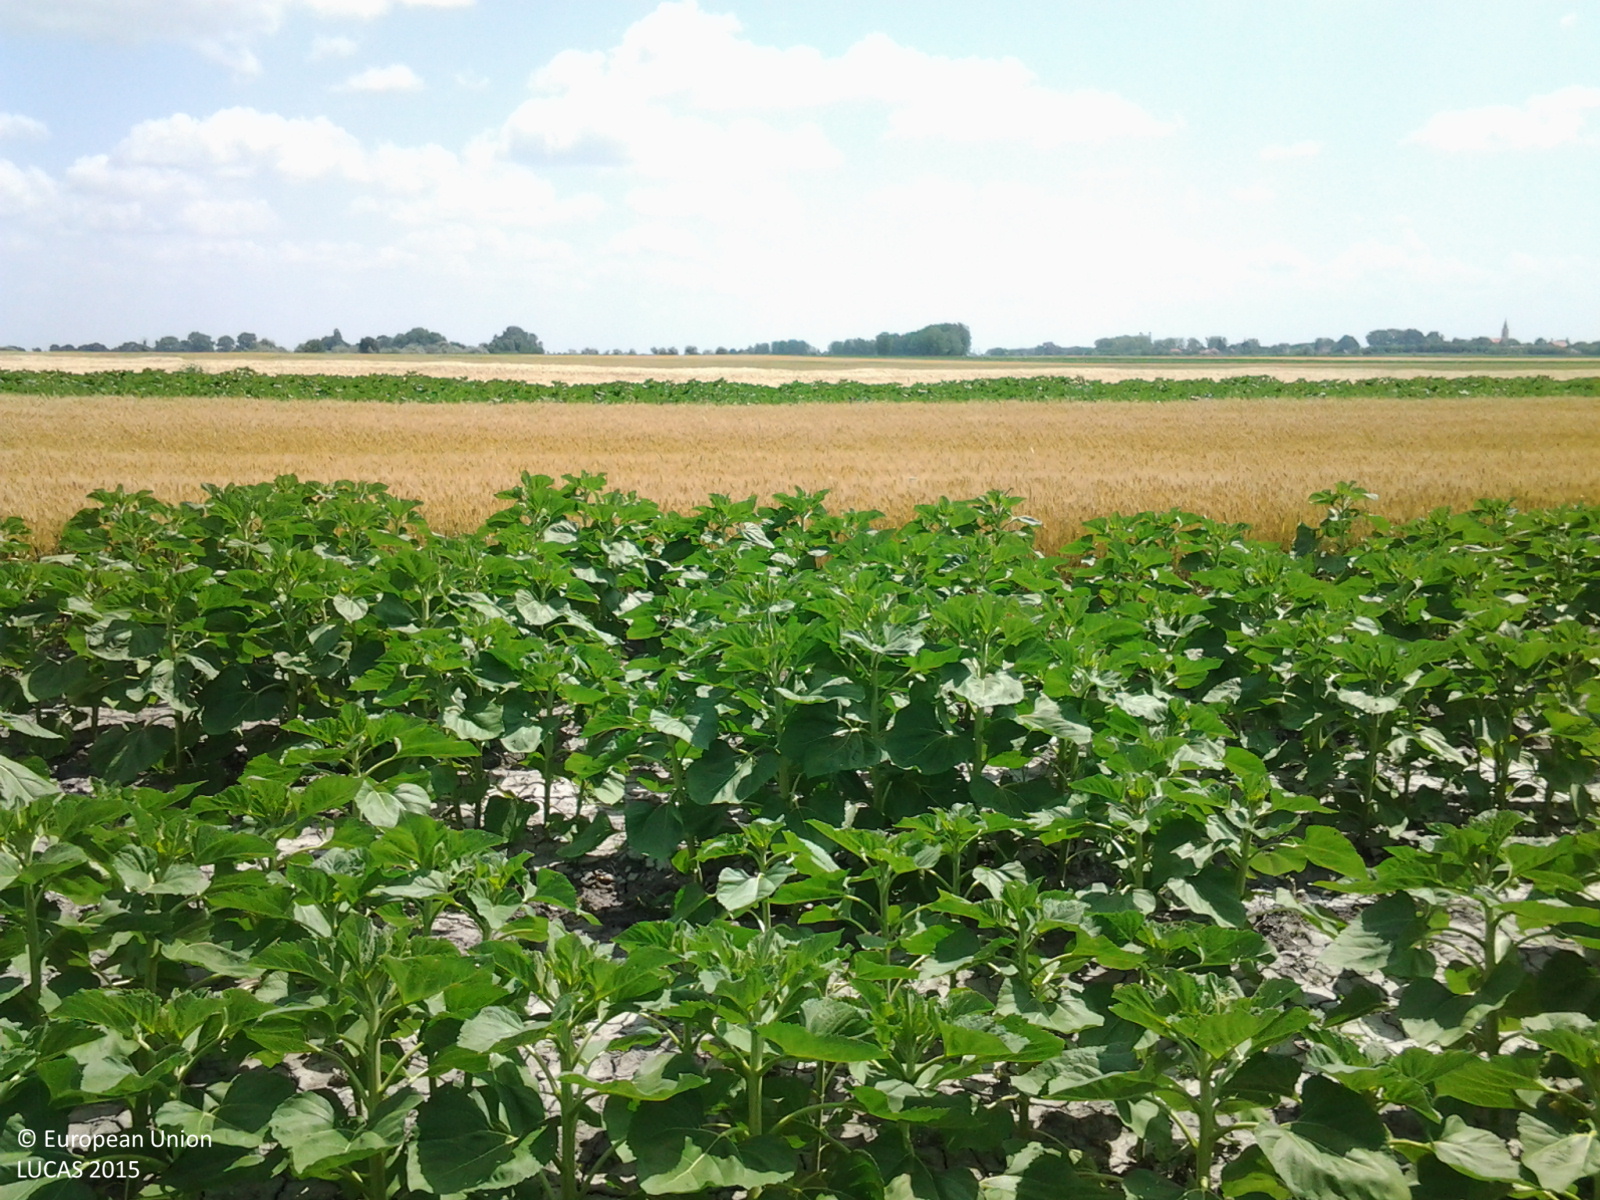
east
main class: Cropland
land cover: Sunflower
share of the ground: > 75 %
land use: Agriculture (excluding fallow land and kitchen gardens)
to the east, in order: Sunflower; Common wheat; Sunflower; Barley; Common wheat
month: June
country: HU
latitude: 46.5644
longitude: 19.0549
